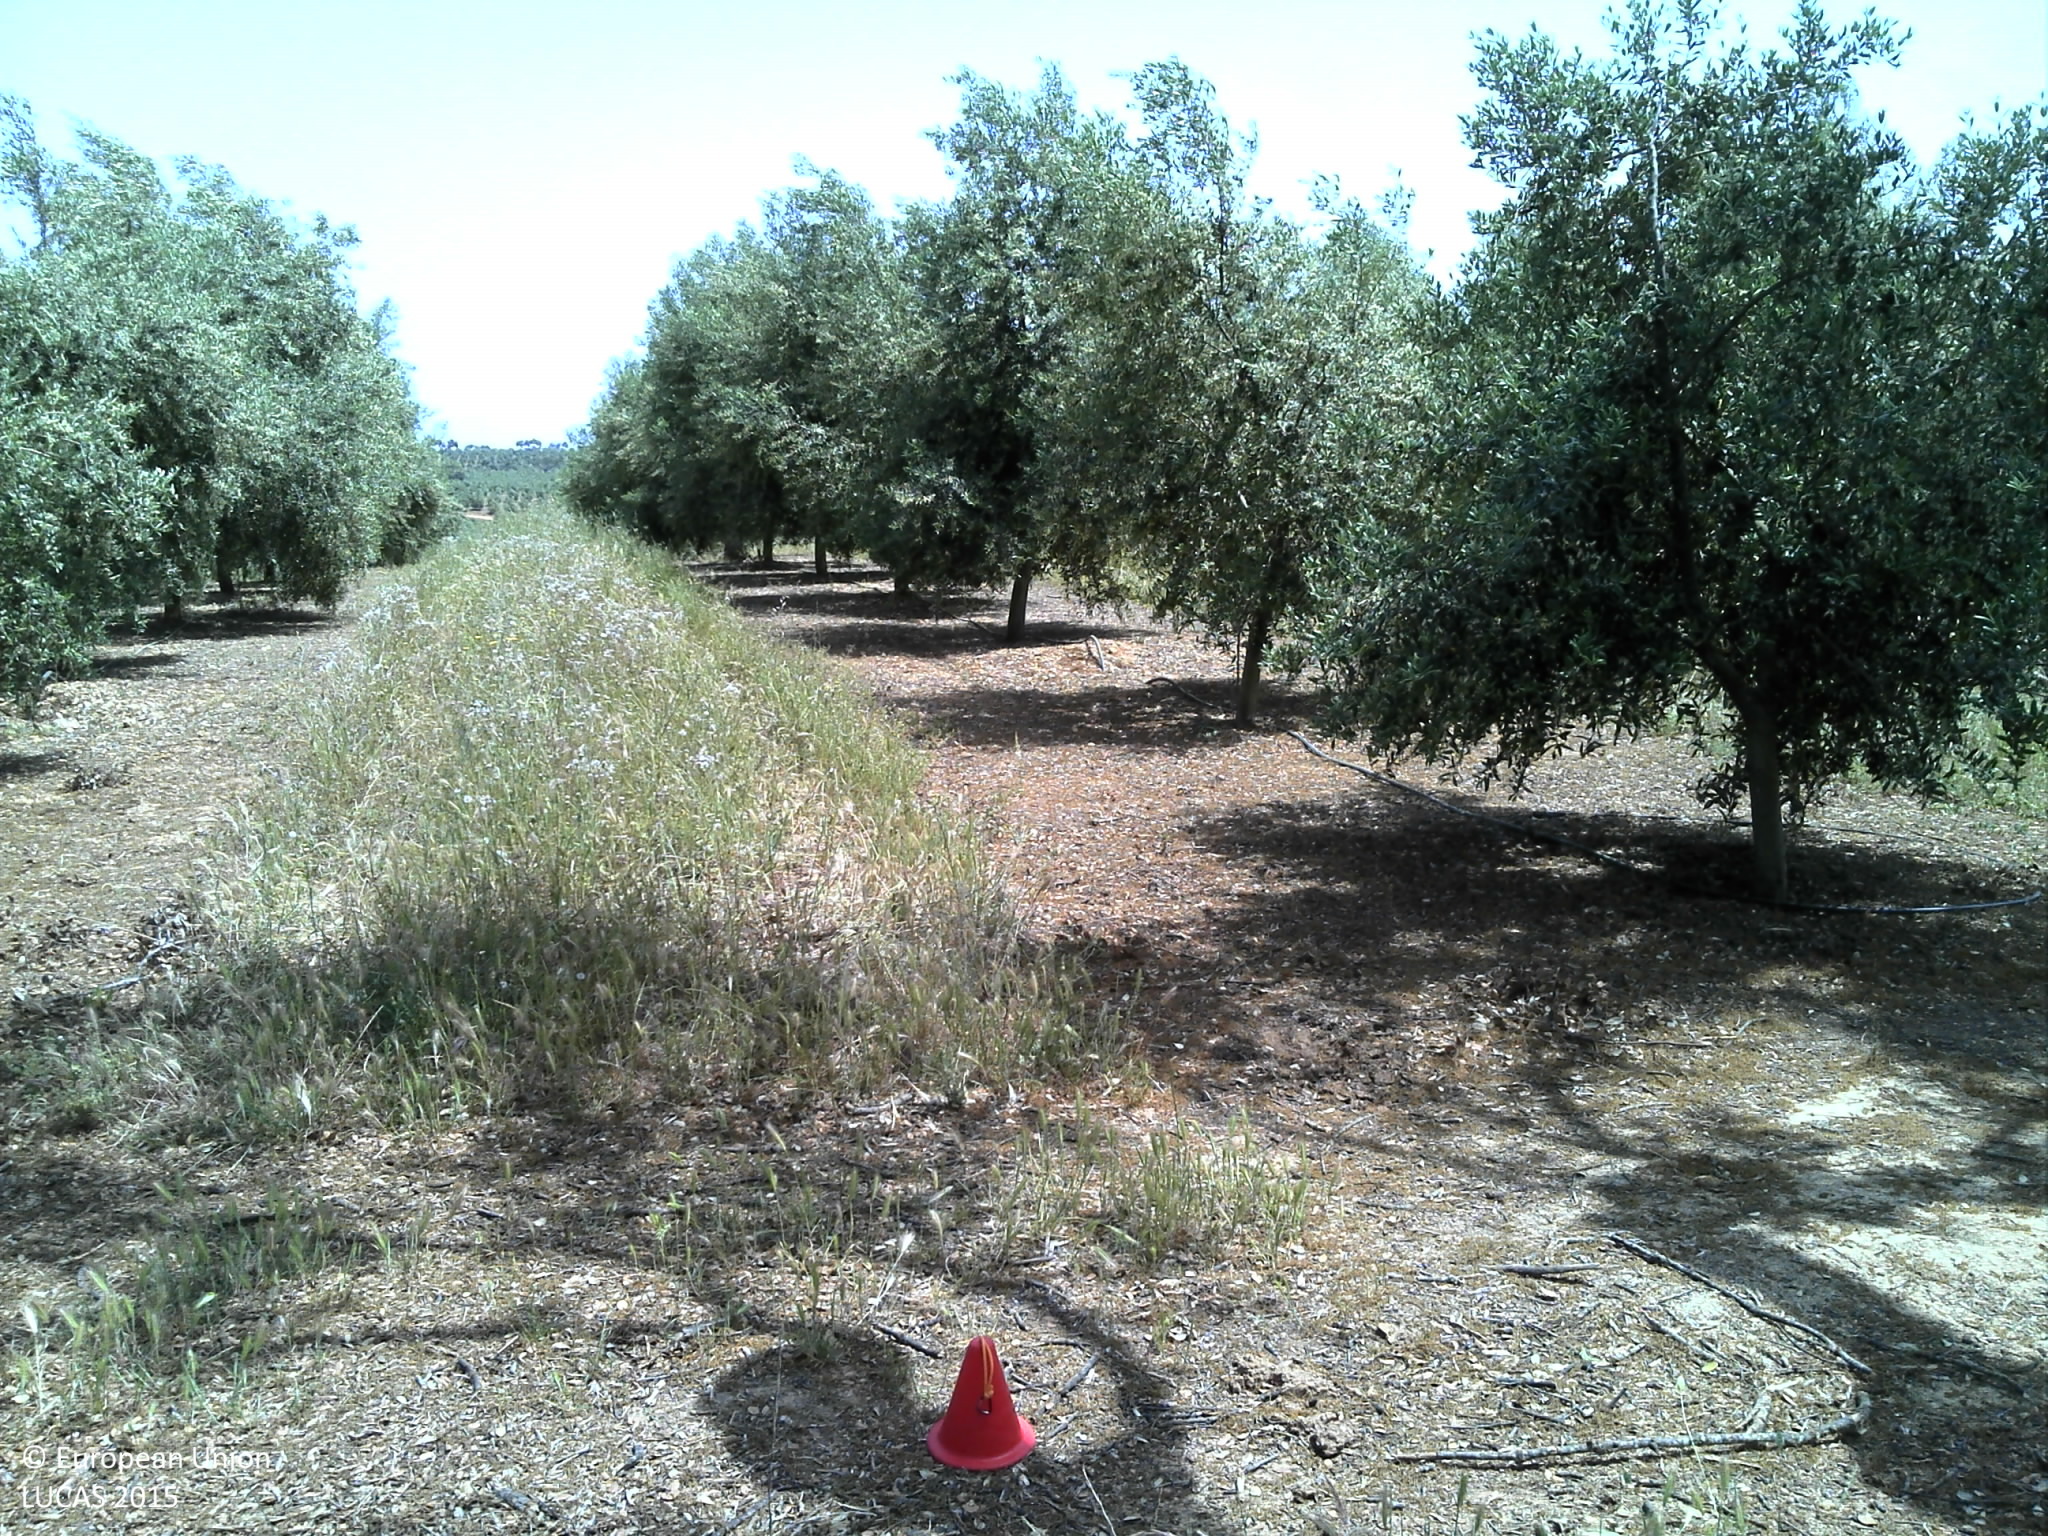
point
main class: Cropland
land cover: Olive groves
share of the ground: 25 - 50 %
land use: Agriculture (excluding fallow land and kitchen gardens)
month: May
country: PT
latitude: 39.0051
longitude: -7.8408
